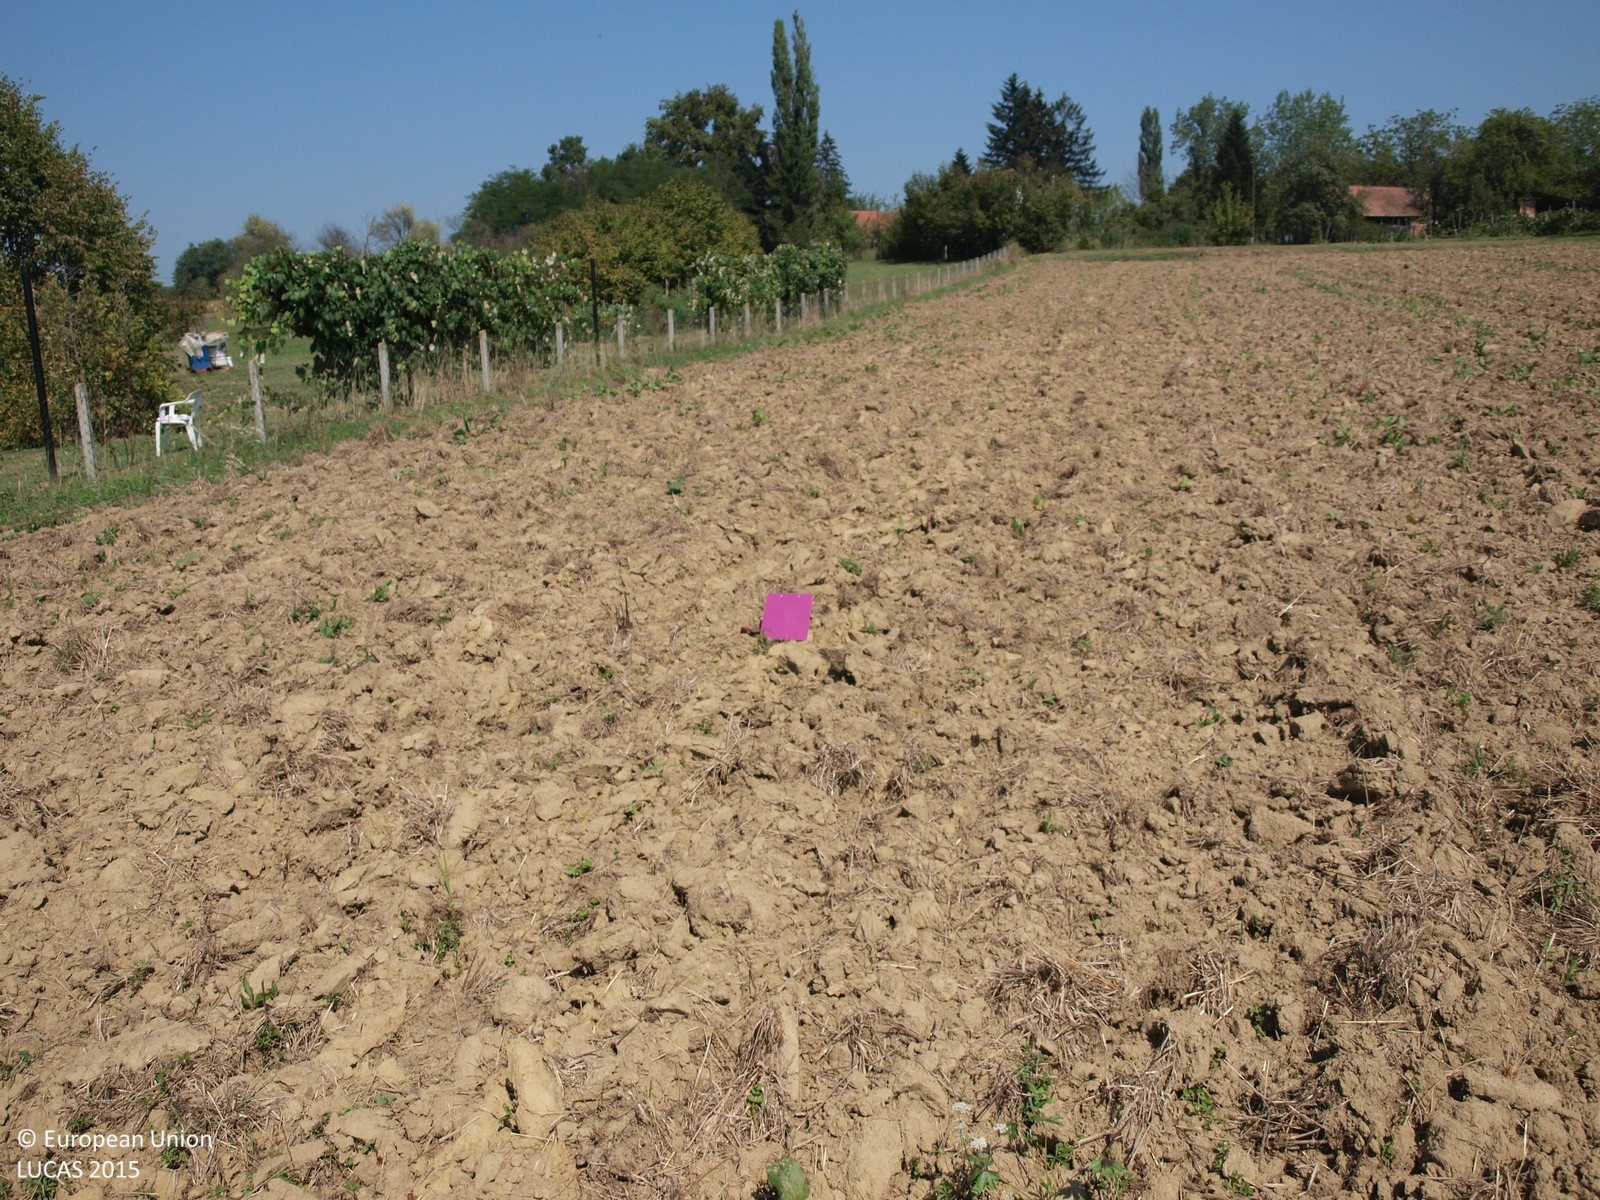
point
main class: Cropland
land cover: Common wheat
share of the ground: > 75 %
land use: Agriculture (excluding fallow land and kitchen gardens)
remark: Harvested field
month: August
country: HR
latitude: 45.7026
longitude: 16.4849
